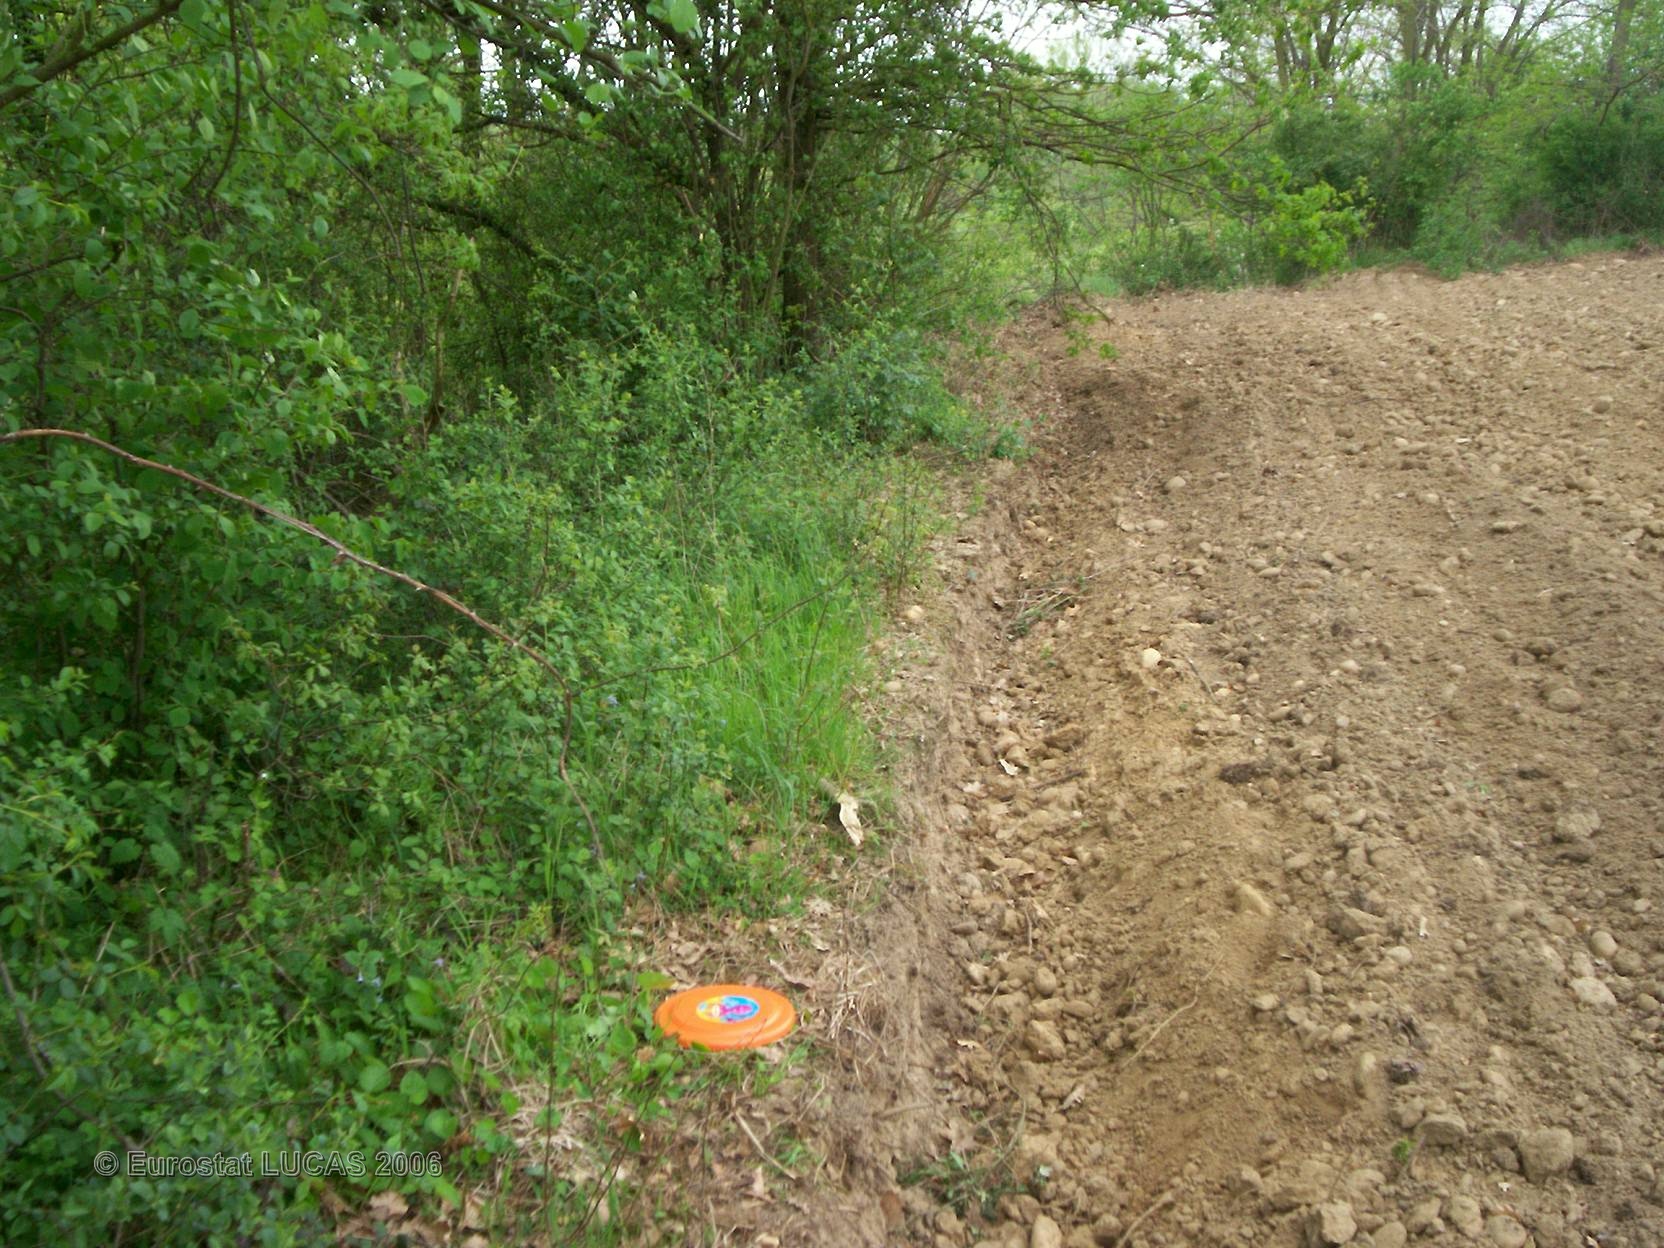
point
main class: Cropland
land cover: Maize
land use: Agriculture (excluding fallow land and kitchen gardens)
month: June
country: FR
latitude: 45.3599
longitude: 4.8343
